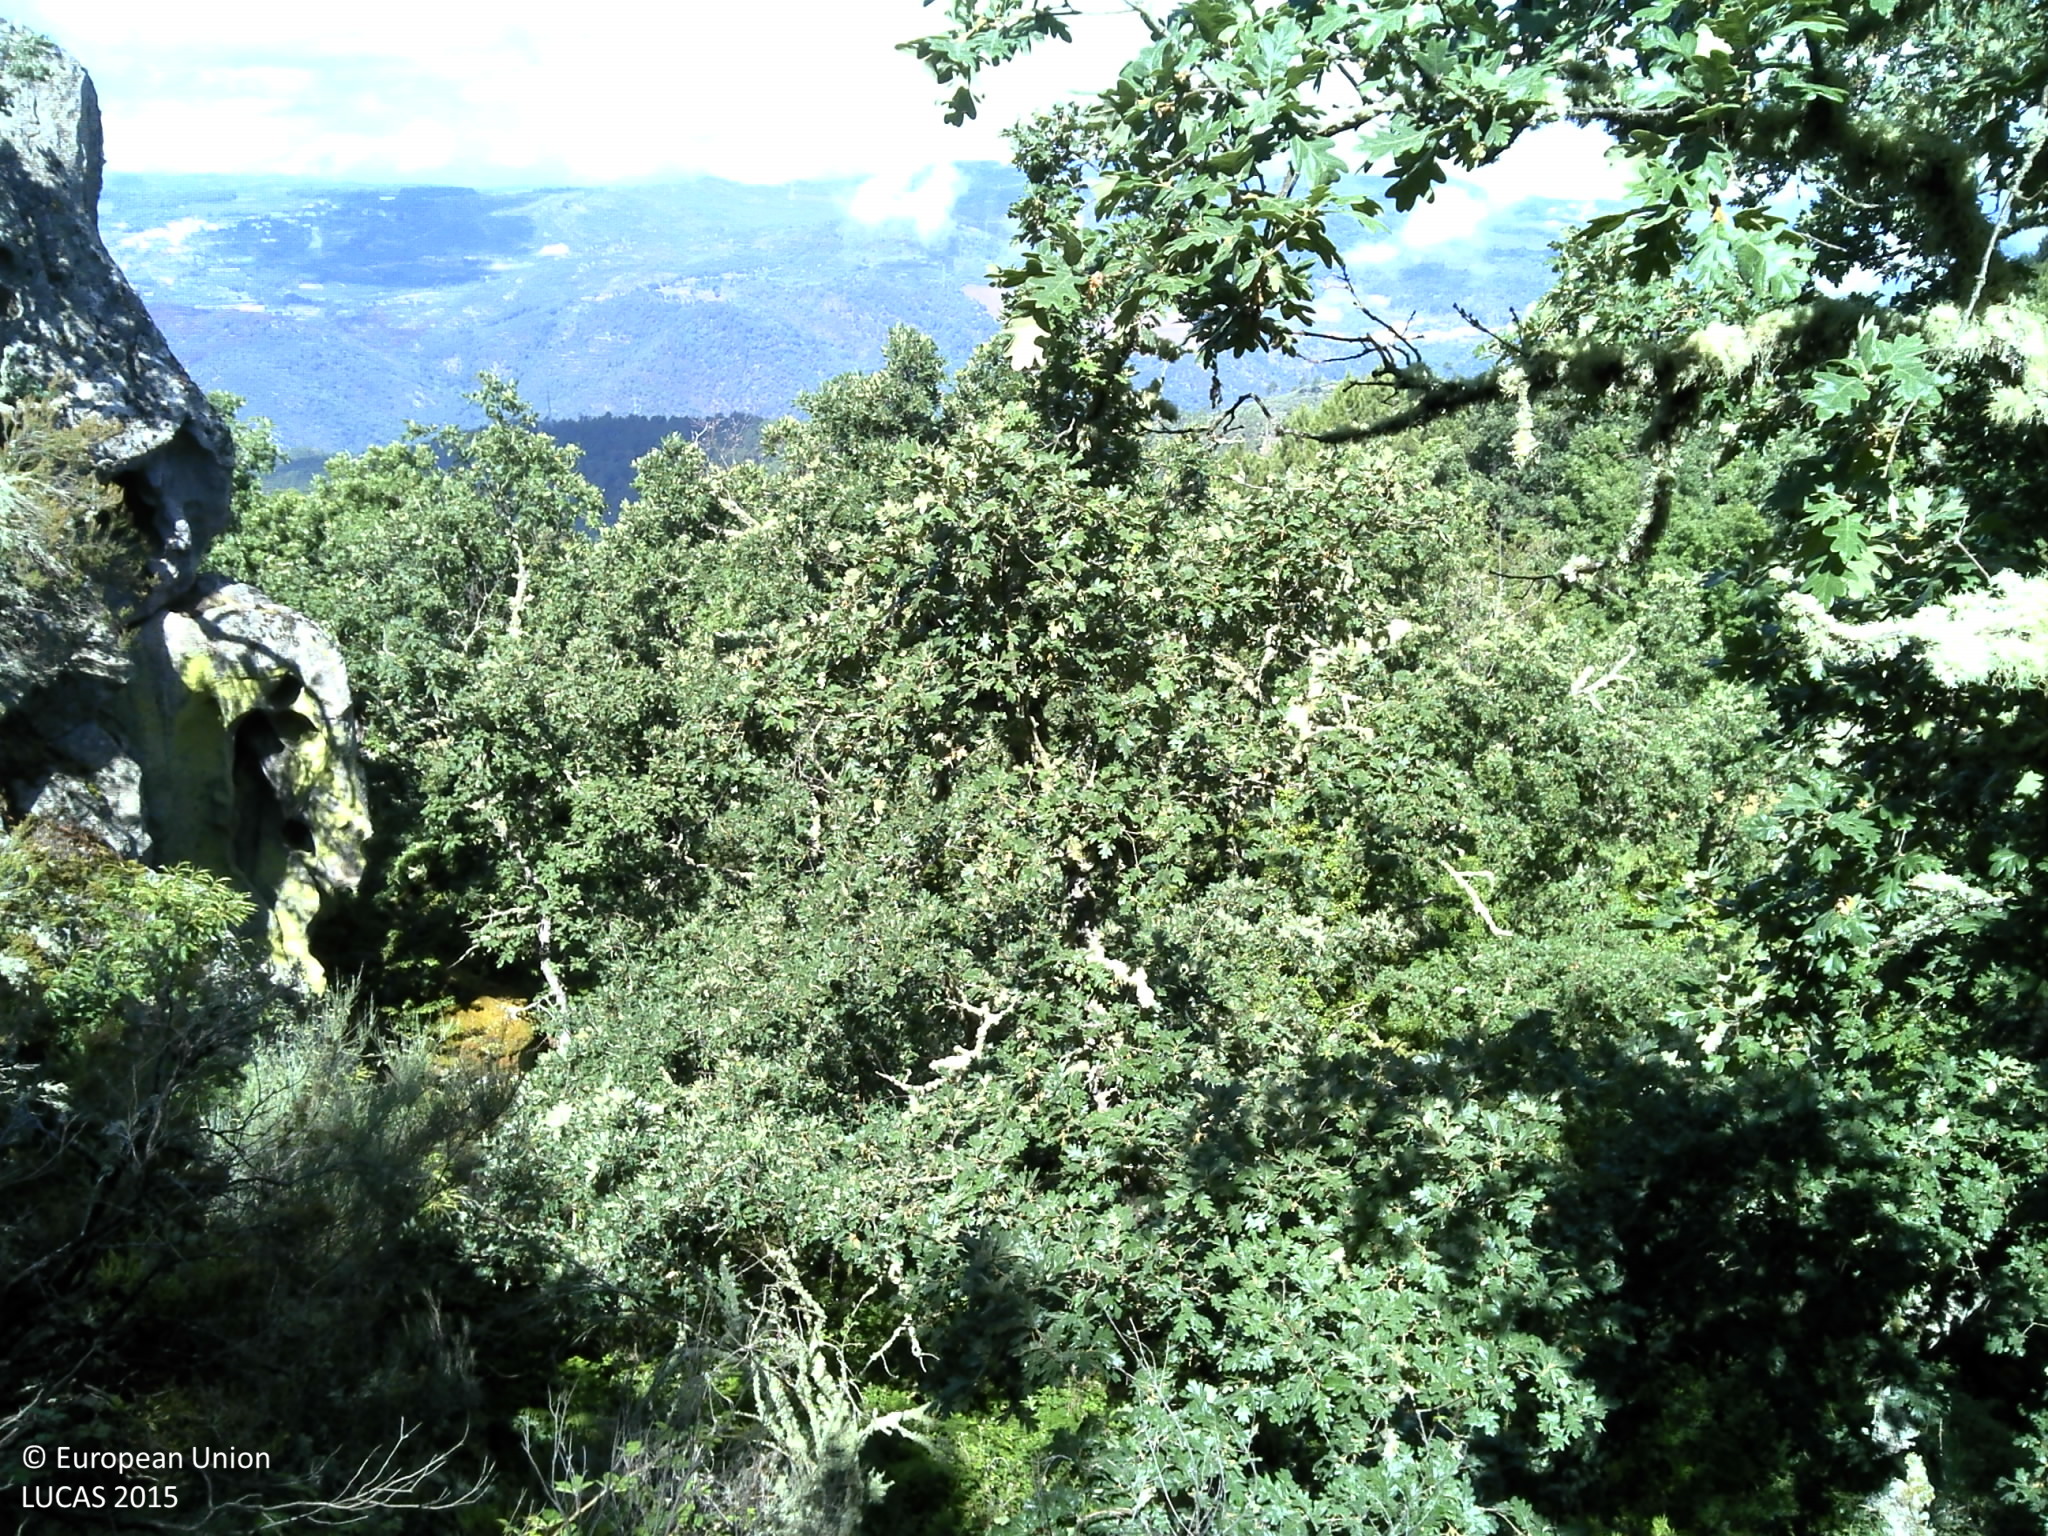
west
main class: Woodland
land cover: Broadleaved woodland
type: acidophilous oak and oak-birch forest
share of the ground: 10 - 25 %
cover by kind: consolidated bare surface 50 %, shrubs 20 %, broadleaved forest trees 15 %, herbaceous plants 10 %, unconsolidated bare surface 5 %
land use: Semi-natural and natural areas not in use
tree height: > 5 m
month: June
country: PT
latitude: 41.0827
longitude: -7.5851
